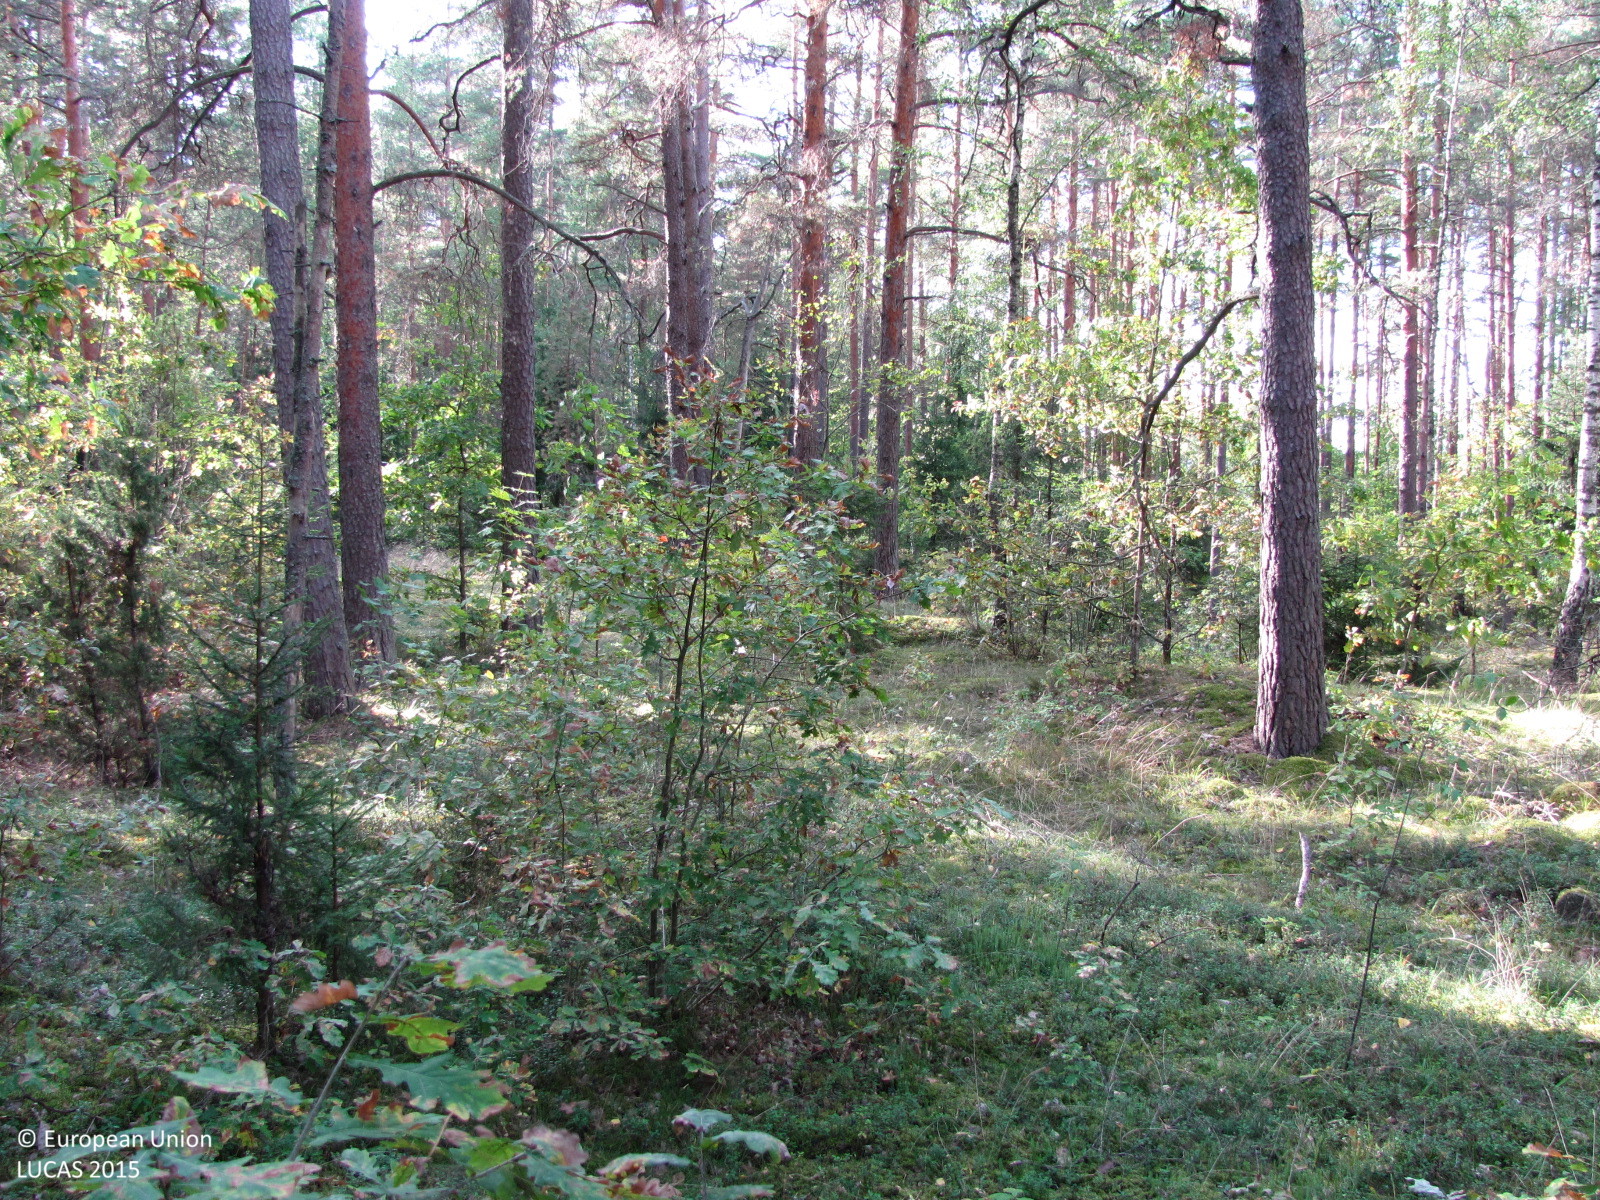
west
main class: Woodland
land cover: Pine dominated mixed woodland
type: hemiboreal forest and nemoral coniferous forest and mixed broadleaved-coniferous forest
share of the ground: > 75 %
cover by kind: coniferous forest trees 60 %, broadleaved forest trees 25 %, herbaceous plants 10 %, lichens and mosses 5 %
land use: Forestry
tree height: > 5 m
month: September
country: LV
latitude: 57.0692
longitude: 24.4243
